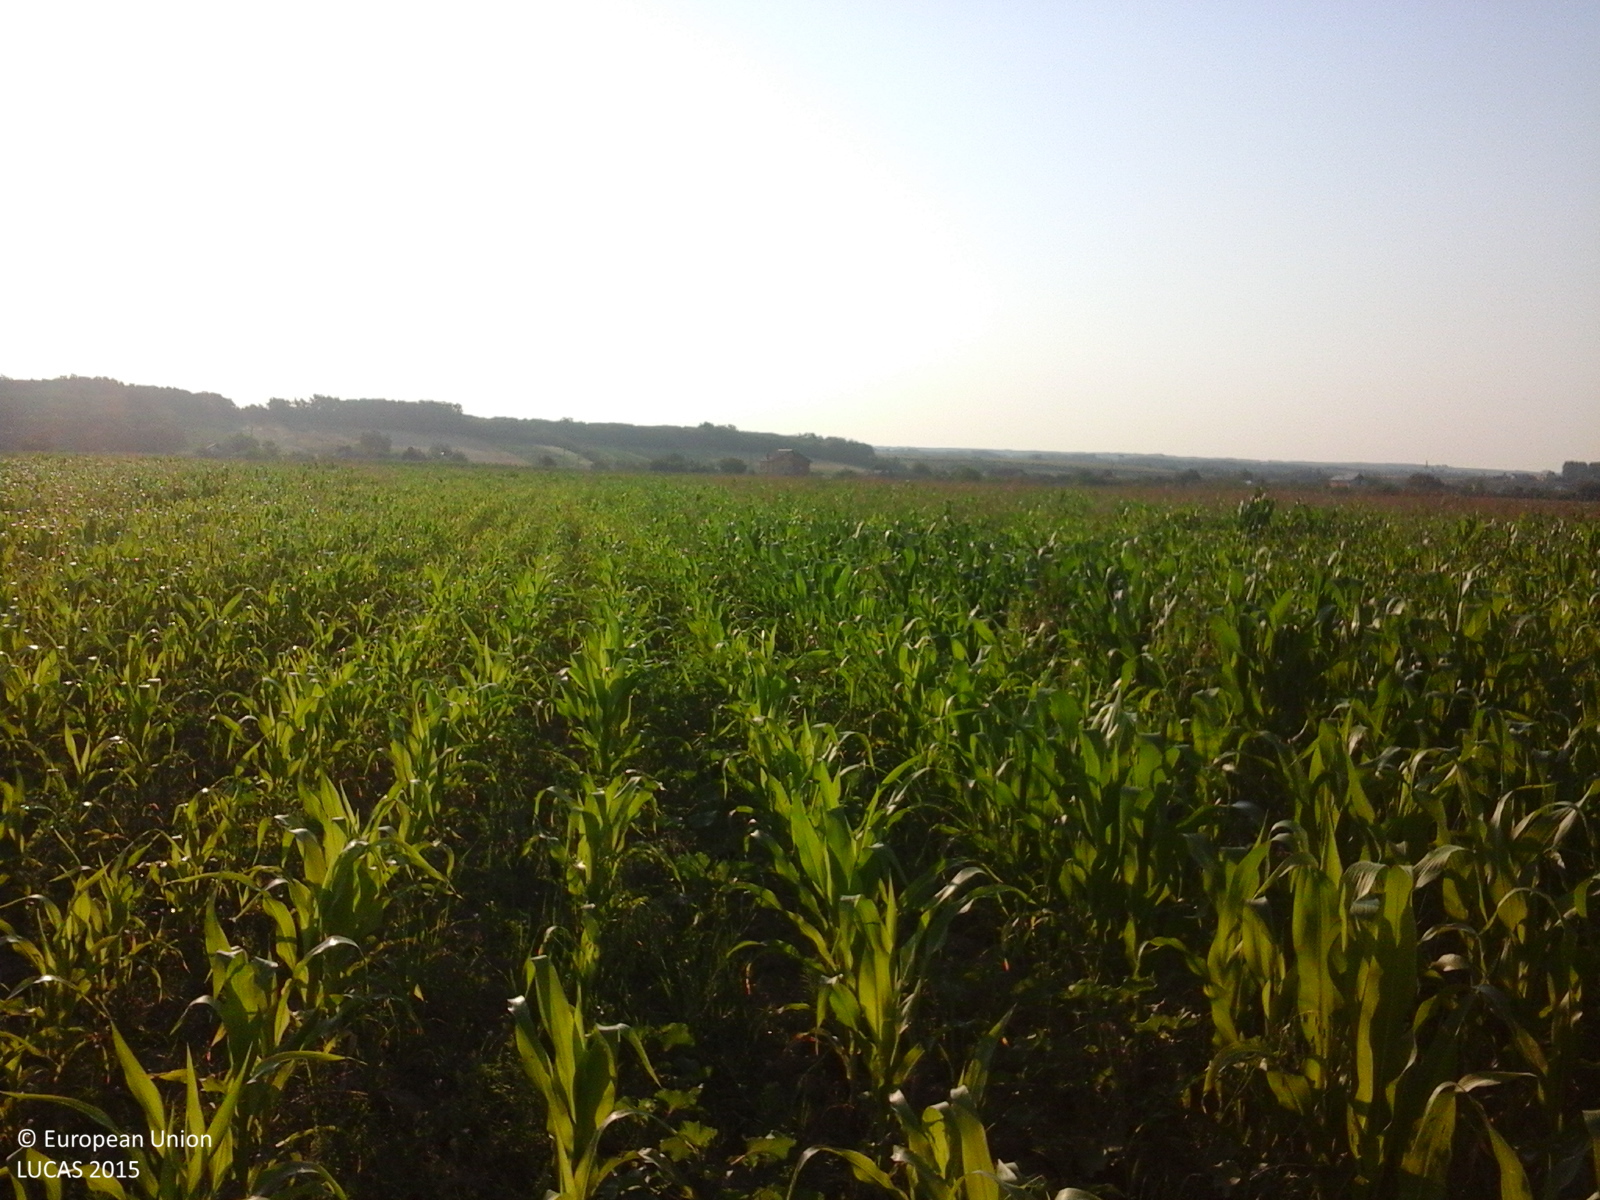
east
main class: Cropland
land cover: Maize
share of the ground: > 75 %
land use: Agriculture (excluding fallow land and kitchen gardens)
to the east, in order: Maize; Common wheat
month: July
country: RO
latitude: 44.7439
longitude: 24.3032
